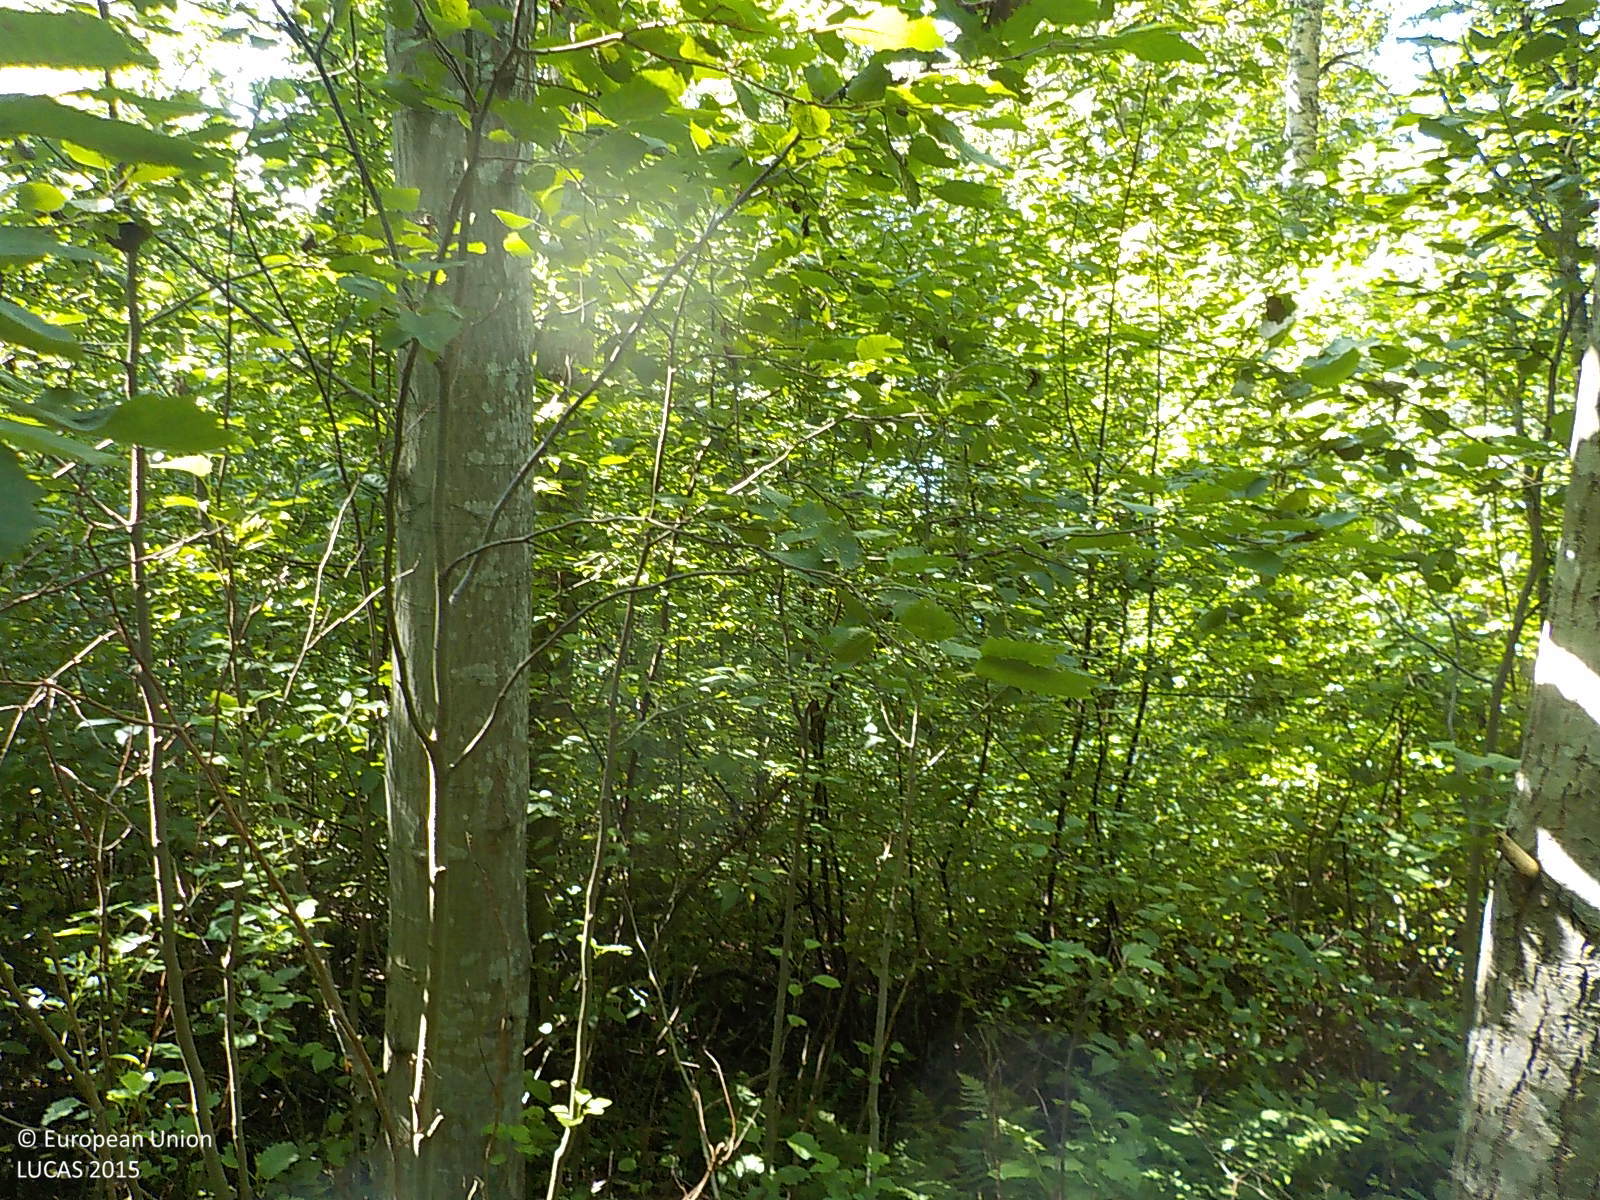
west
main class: Woodland
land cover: Broadleaved woodland
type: hemiboreal forest and nemoral coniferous forest and mixed broadleaved-coniferous forest
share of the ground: > 75 %
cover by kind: broadleaved forest trees 95 %, herbaceous plants 5 %
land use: Forestry
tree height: > 5 m
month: August
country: SE
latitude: 63.3251
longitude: 18.6630
